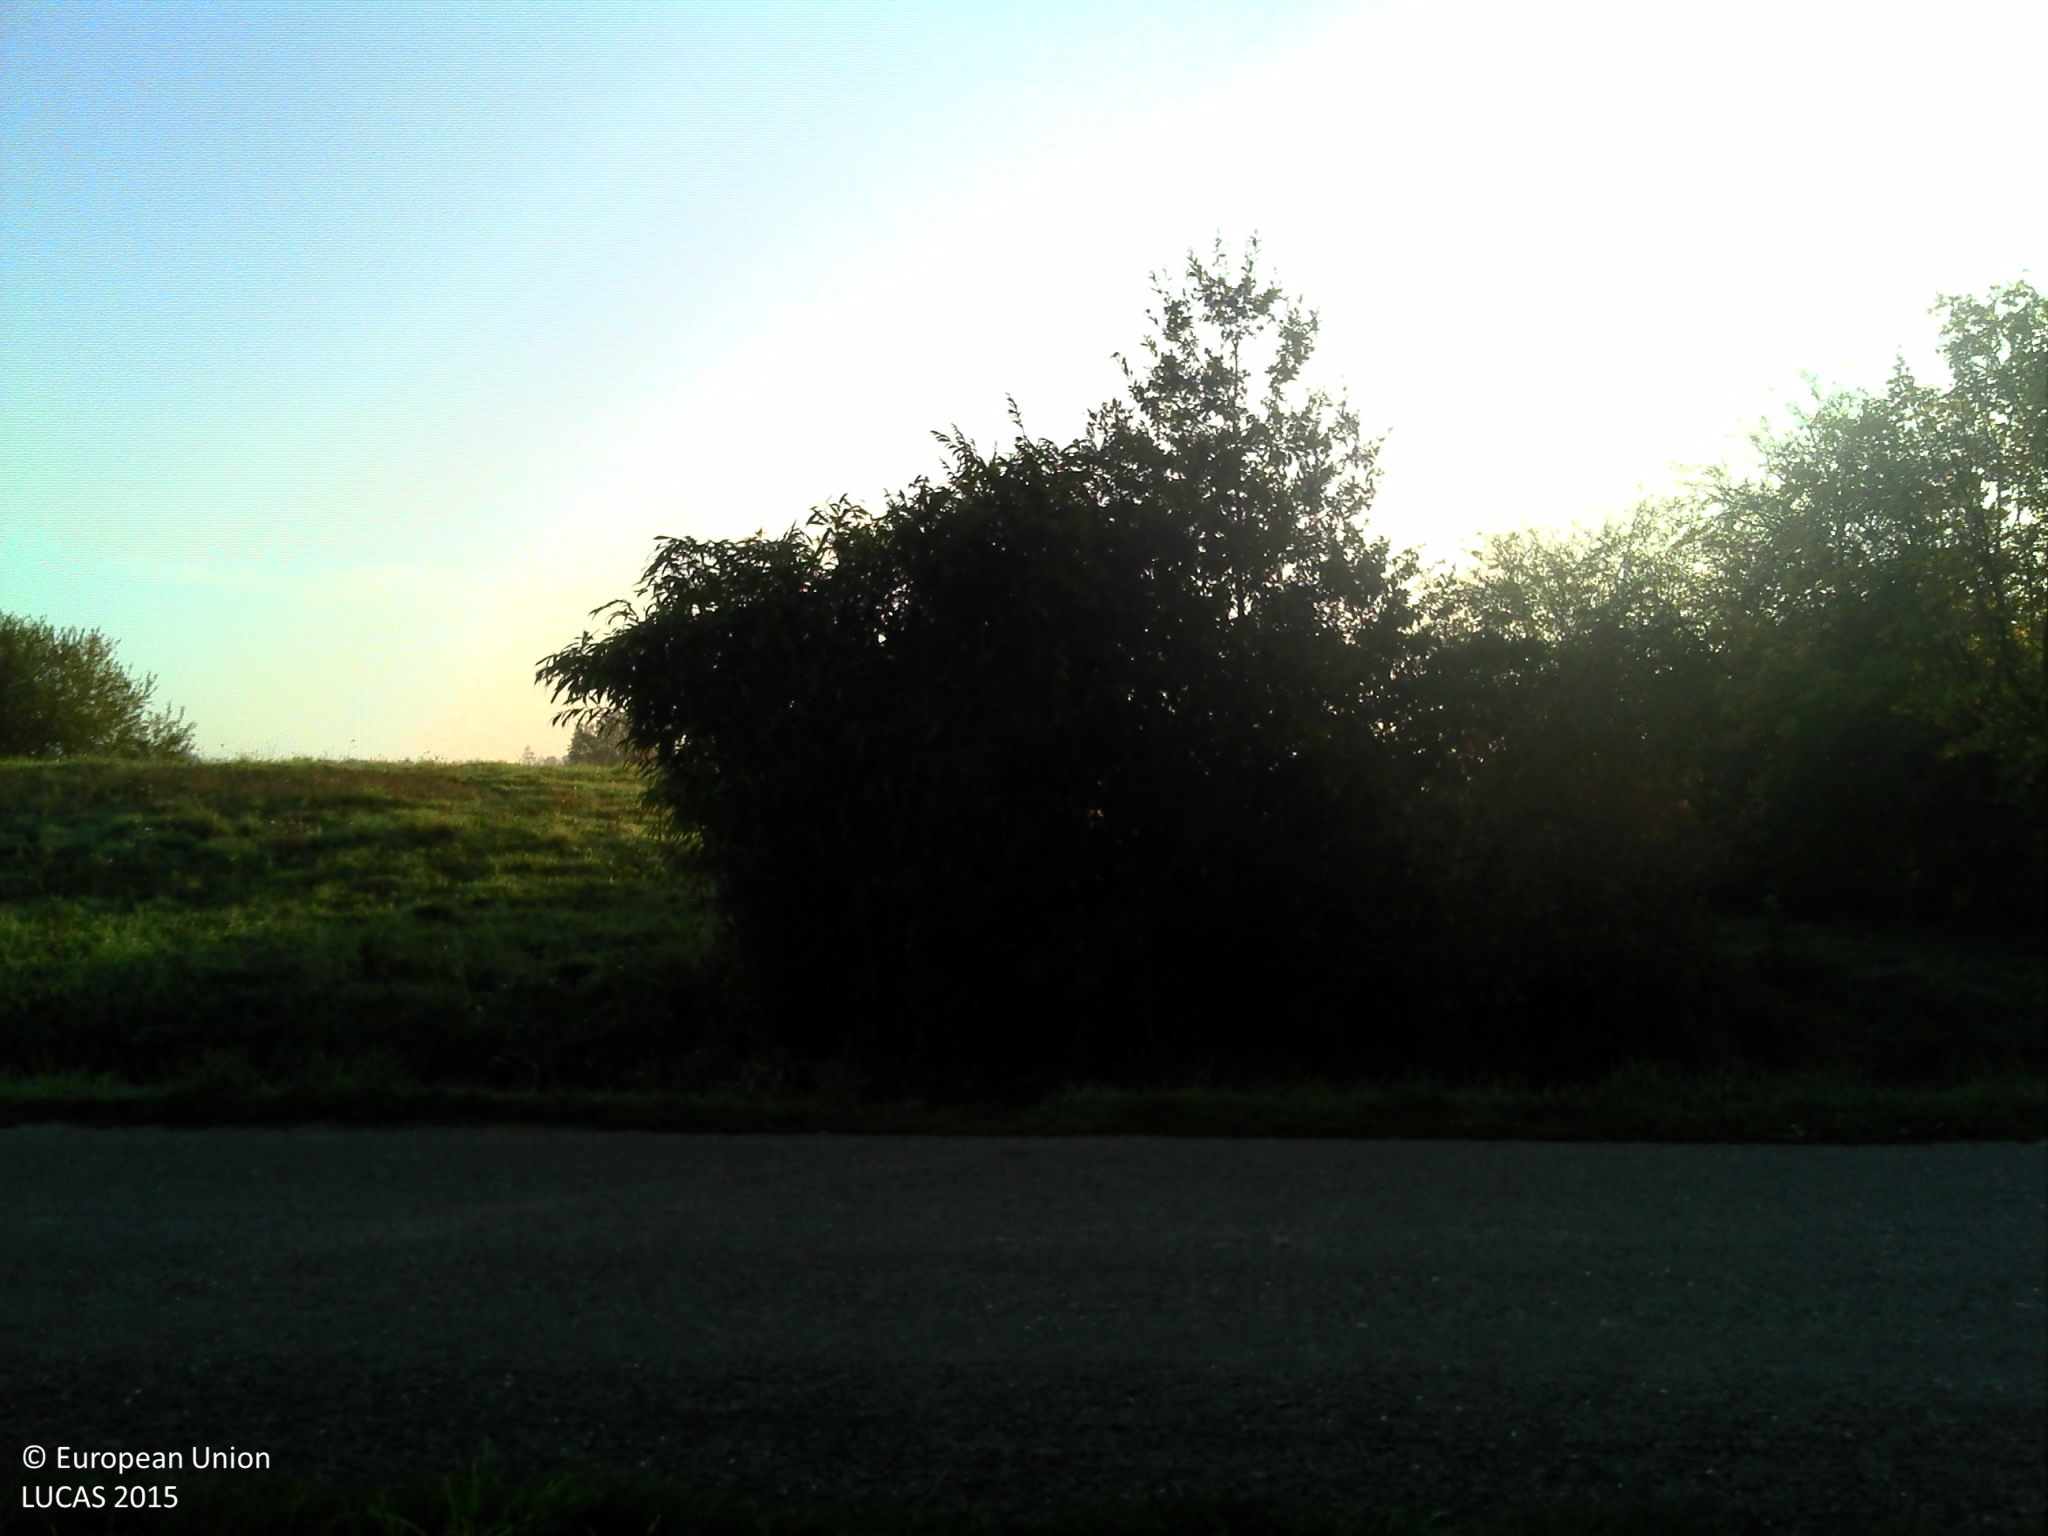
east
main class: Cropland
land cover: Maize
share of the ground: > 75 %
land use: Agriculture (excluding fallow land and kitchen gardens)
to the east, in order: Maize; Grass margins; Ditches and canals; Grass margins; Paved roads, cycling and walking lanes; Grass margins; Ditches and canals; Grassland without tree/shrub cover; Inland fresh water bodies; Grassland without tree/shrub cover; Abandoned hedges; Maize; Temporary grasslands
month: October
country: FR
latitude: 48.0616
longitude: -2.2808
